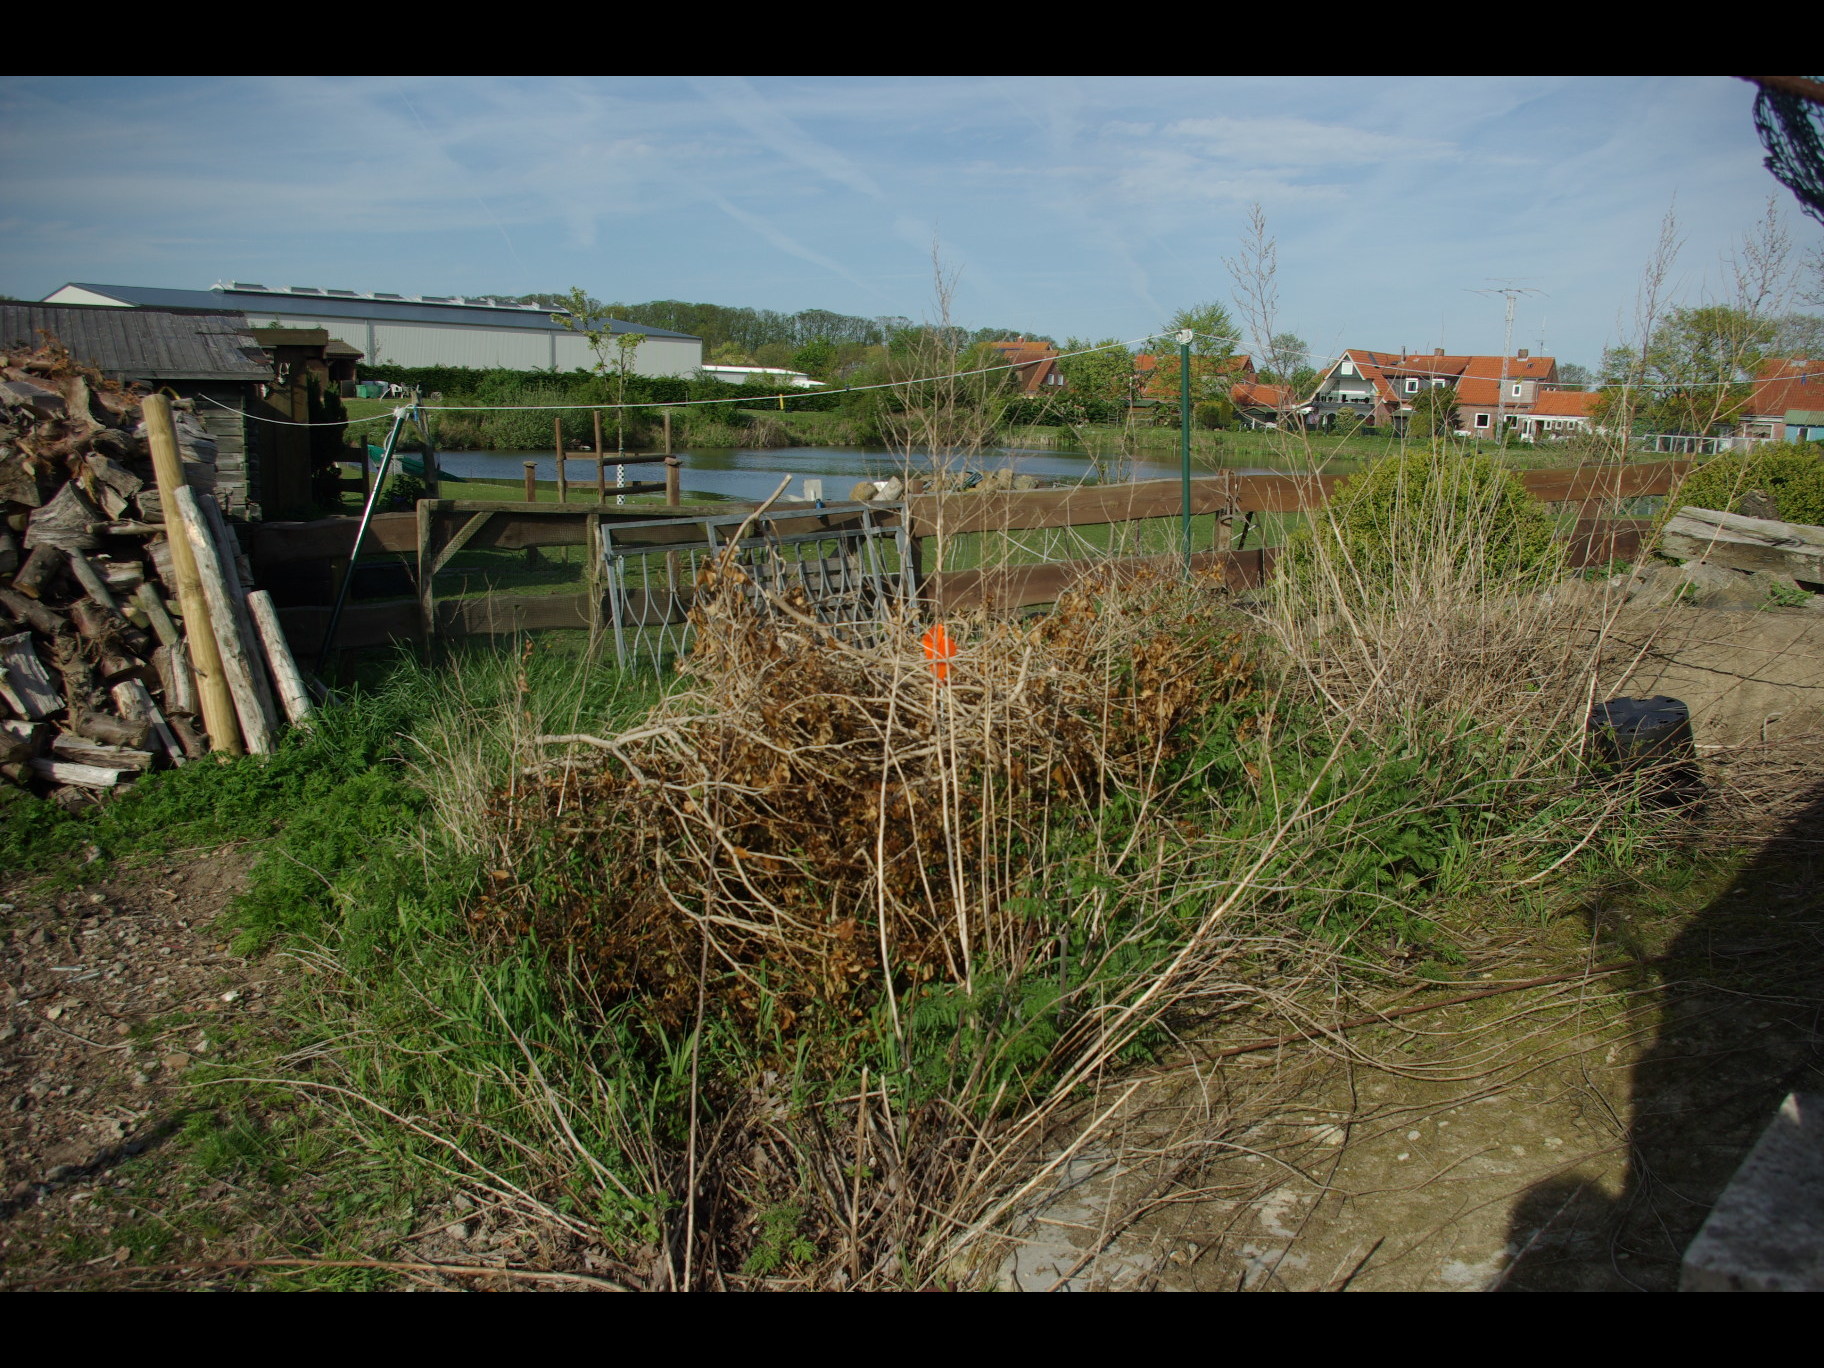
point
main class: Grassland
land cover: Spontaneously vegetated surfaces
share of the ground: > 75 %
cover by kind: herbaceous plants 100 %
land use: Residential
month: May
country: DE
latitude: 54.4386
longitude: 11.1865
